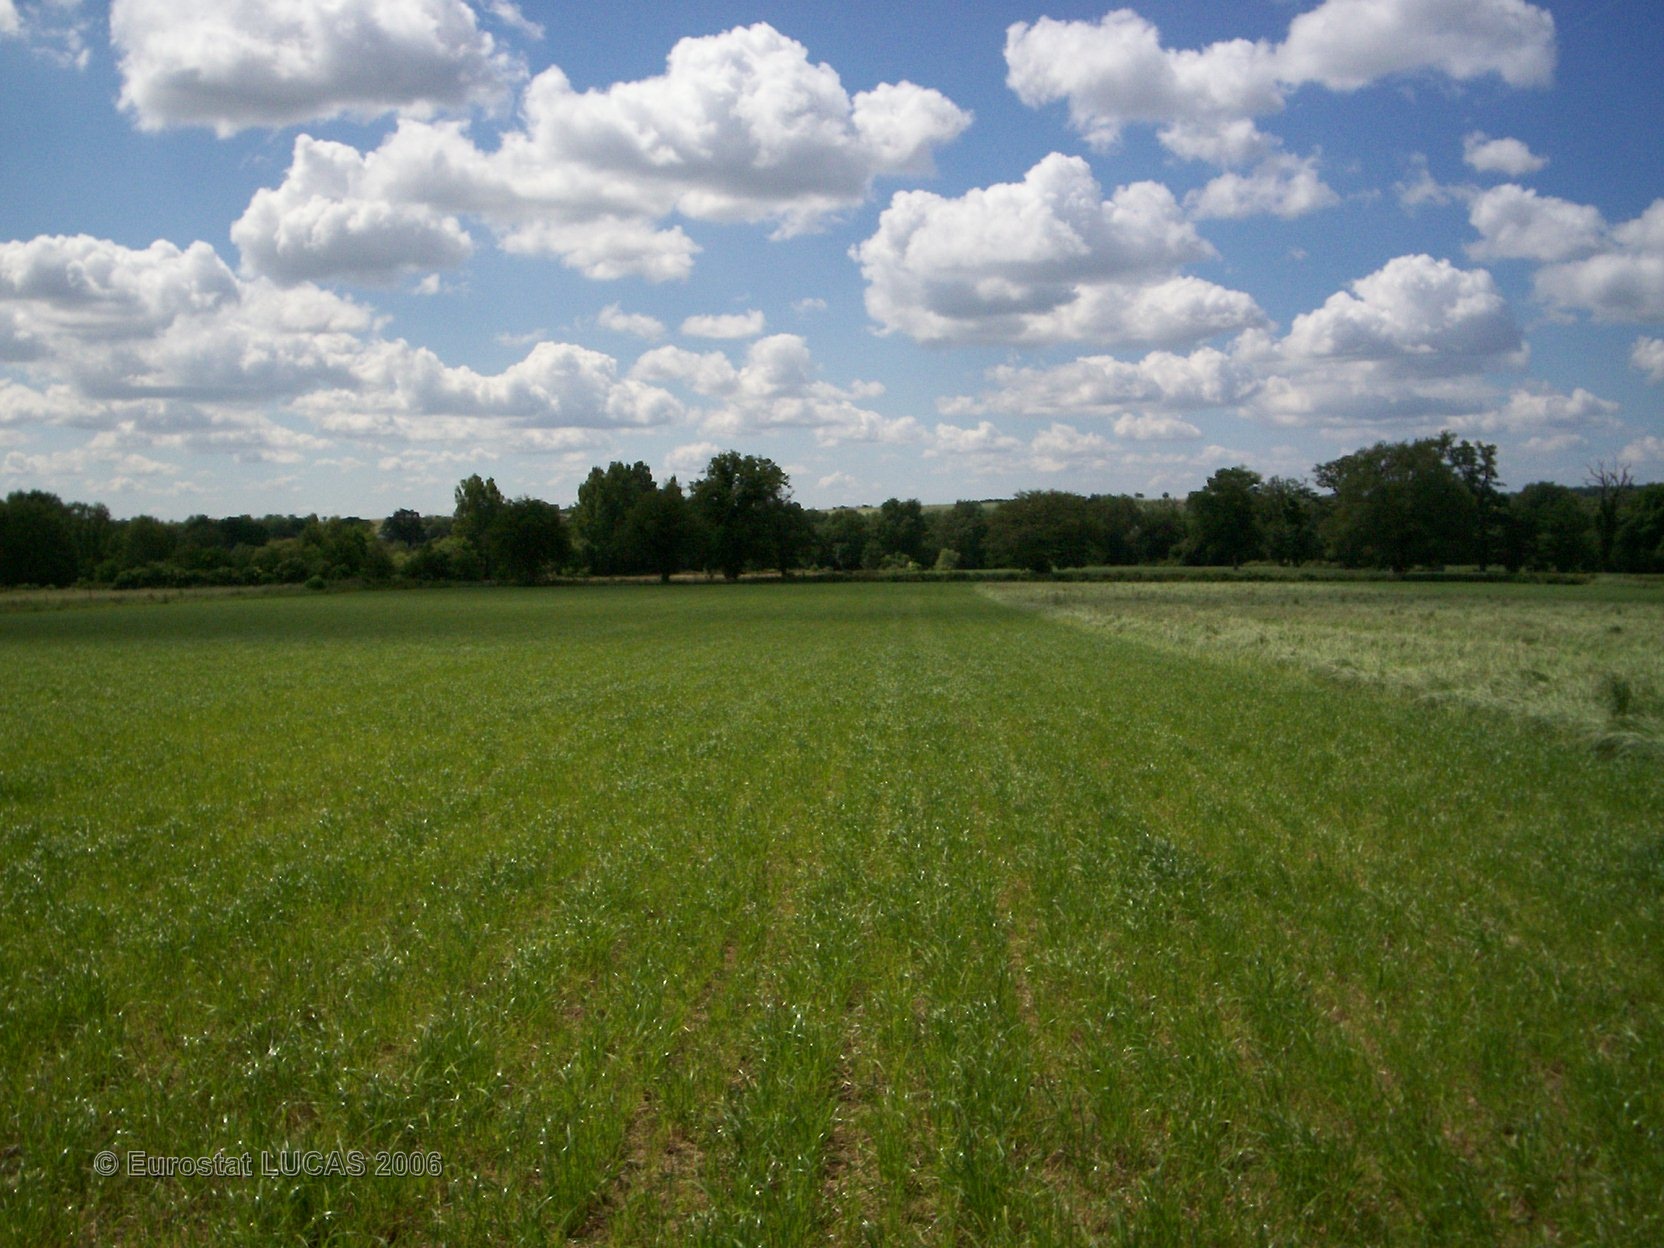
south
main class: Grassland
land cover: Grassland without tree/shrub cover
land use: Agriculture (excluding fallow land and kitchen gardens)
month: May
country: FR
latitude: 47.5309
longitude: -1.1296
